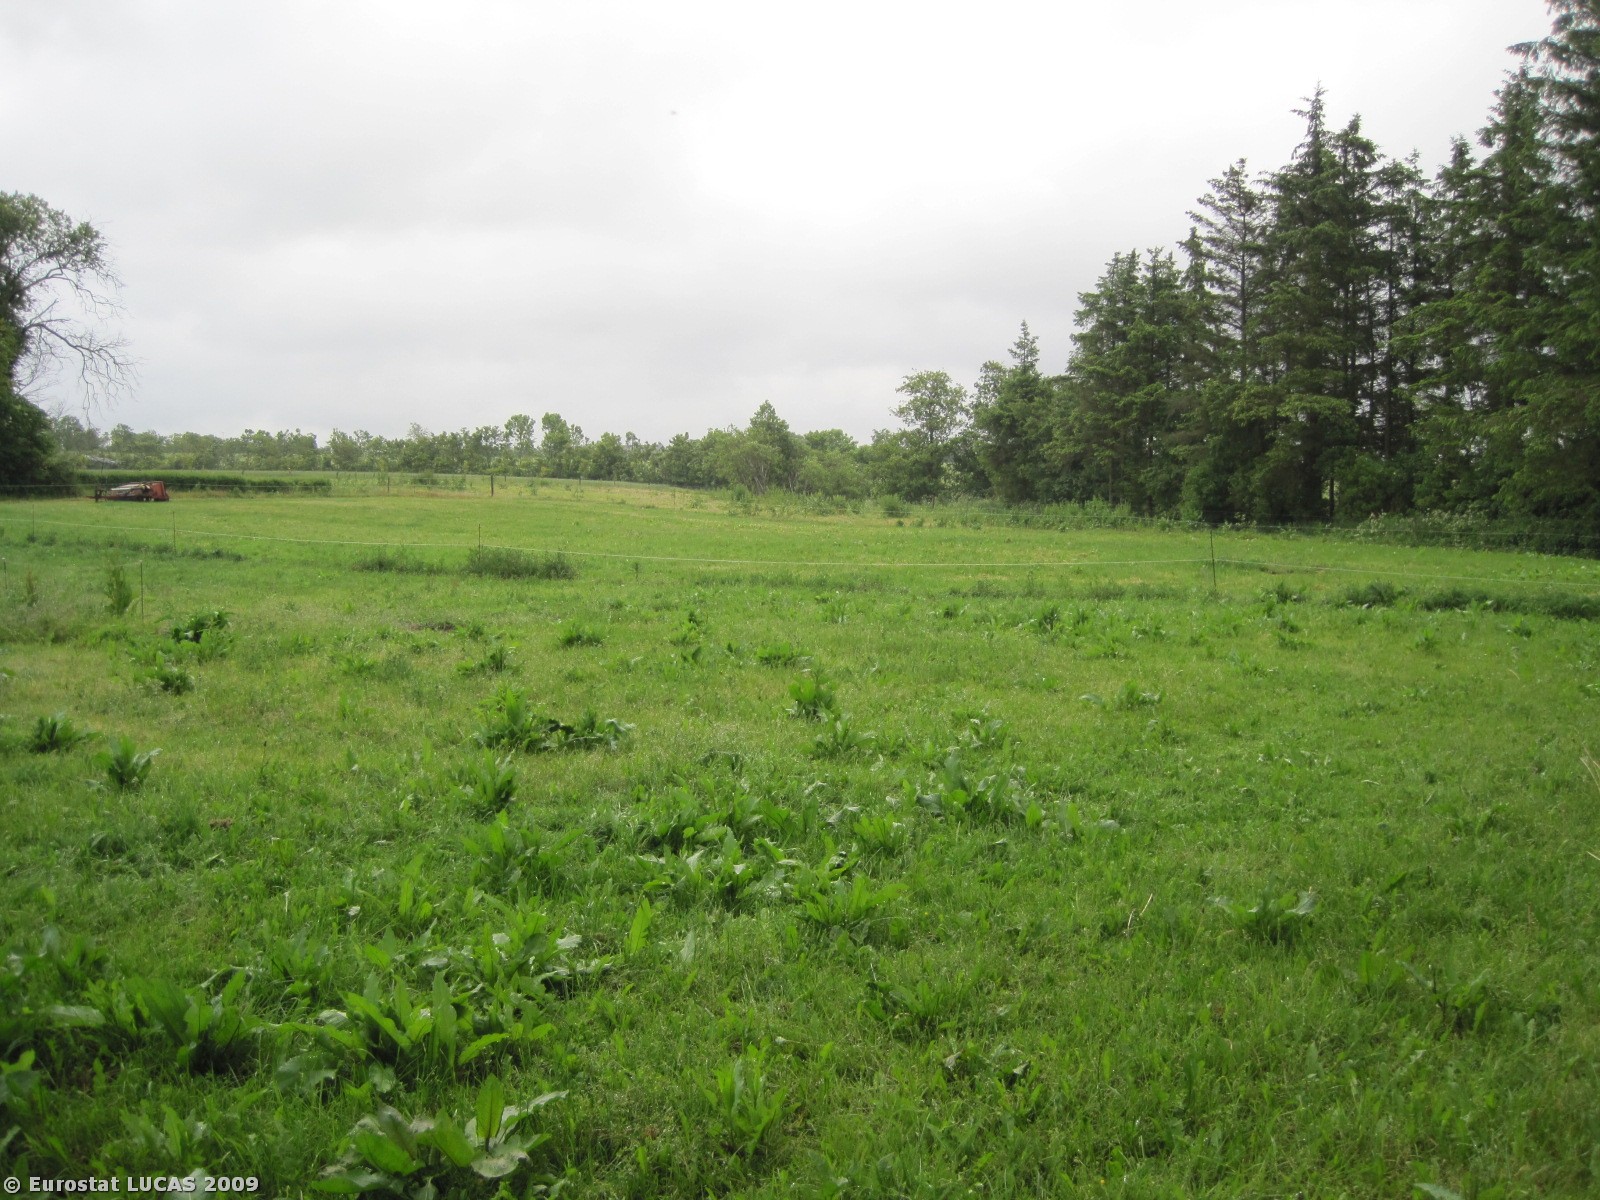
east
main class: Woodland
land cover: Mixed woodland
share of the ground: > 75 %
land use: Unused
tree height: > 5 m
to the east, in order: Mixed woodland; Fences; Grassland without tree/shrub cover; Fences; Grassland without tree/shrub cover; Fences; Grassland without tree/shrub cover; Fences; Broadleaved woodland; Fences; Grassland without tree/shrub cover; Fences; Grass margins; Tracks; Grass margins; Common wheat; Grass margins; Paved roads, cycling and walking lanes; Grassland without tree/shrub cover; Broadleaved woodland; Rape and turnip rape
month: June
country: DK
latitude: 57.5179
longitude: 10.2500
